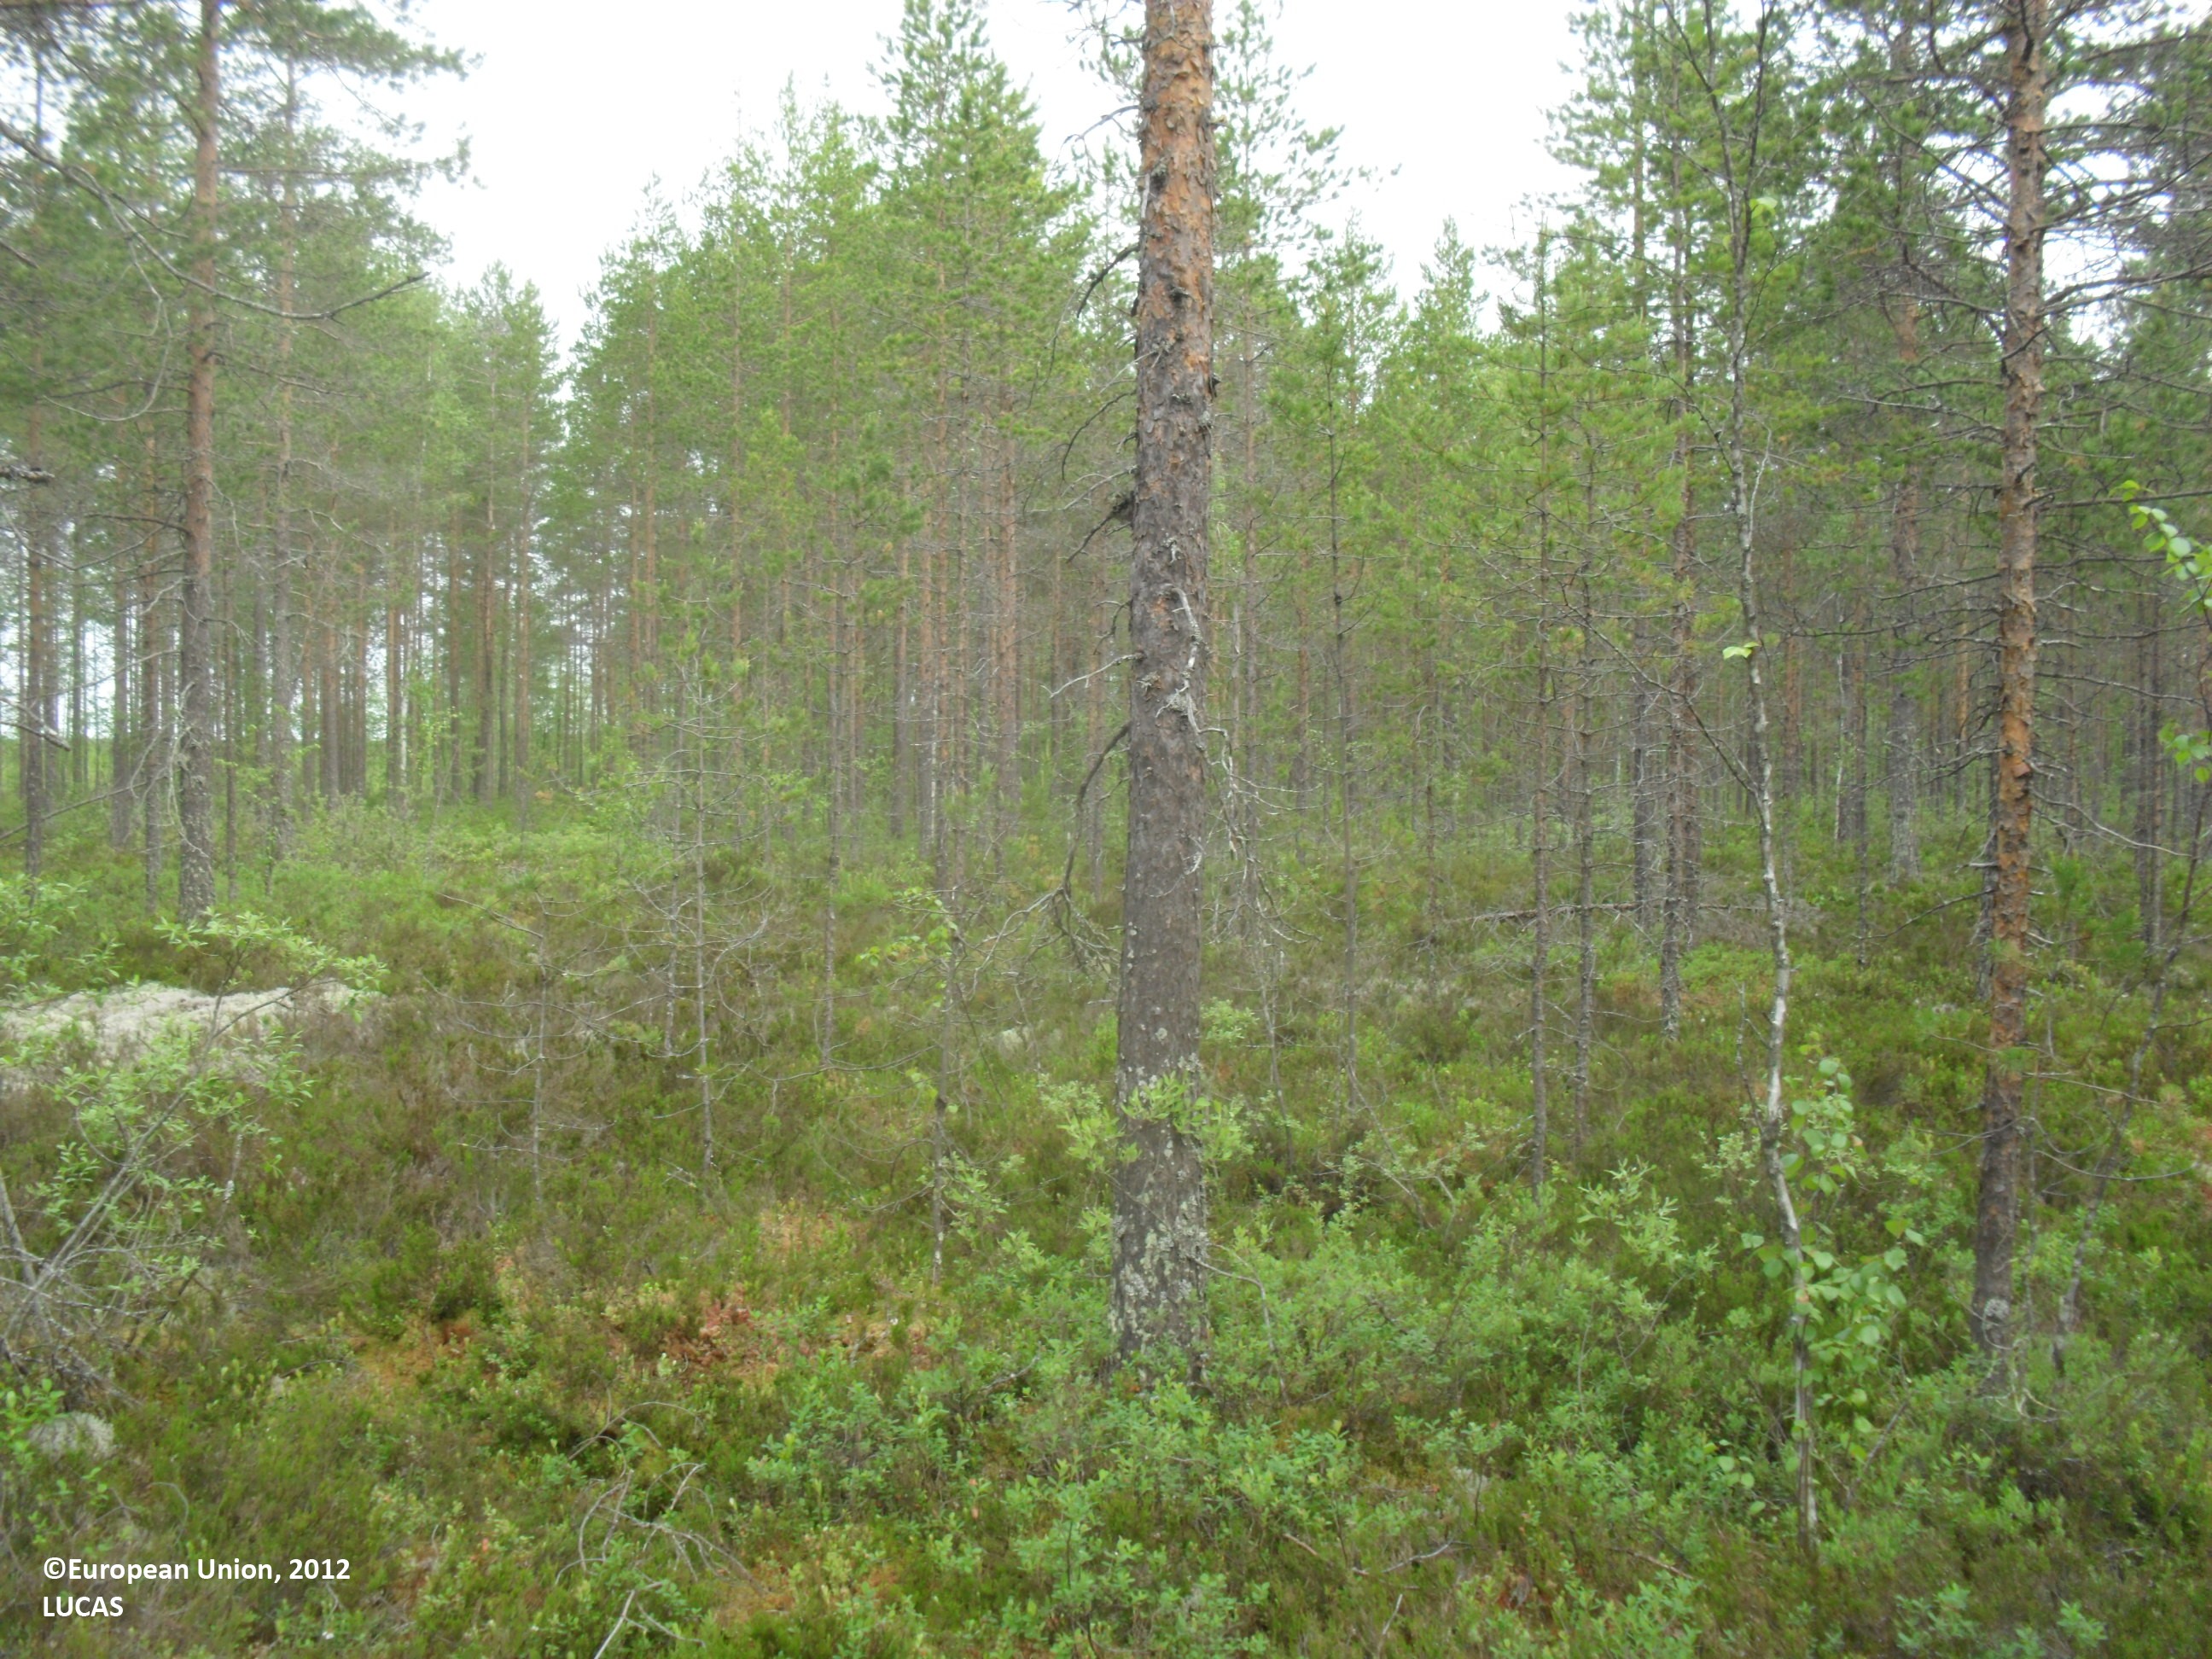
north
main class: Woodland
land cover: Pine dominated coniferous woodland
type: boreal forest
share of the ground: 25 - 50 %
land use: Forestry
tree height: > 5 m
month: June
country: FI
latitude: 62.8431
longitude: 23.7205
